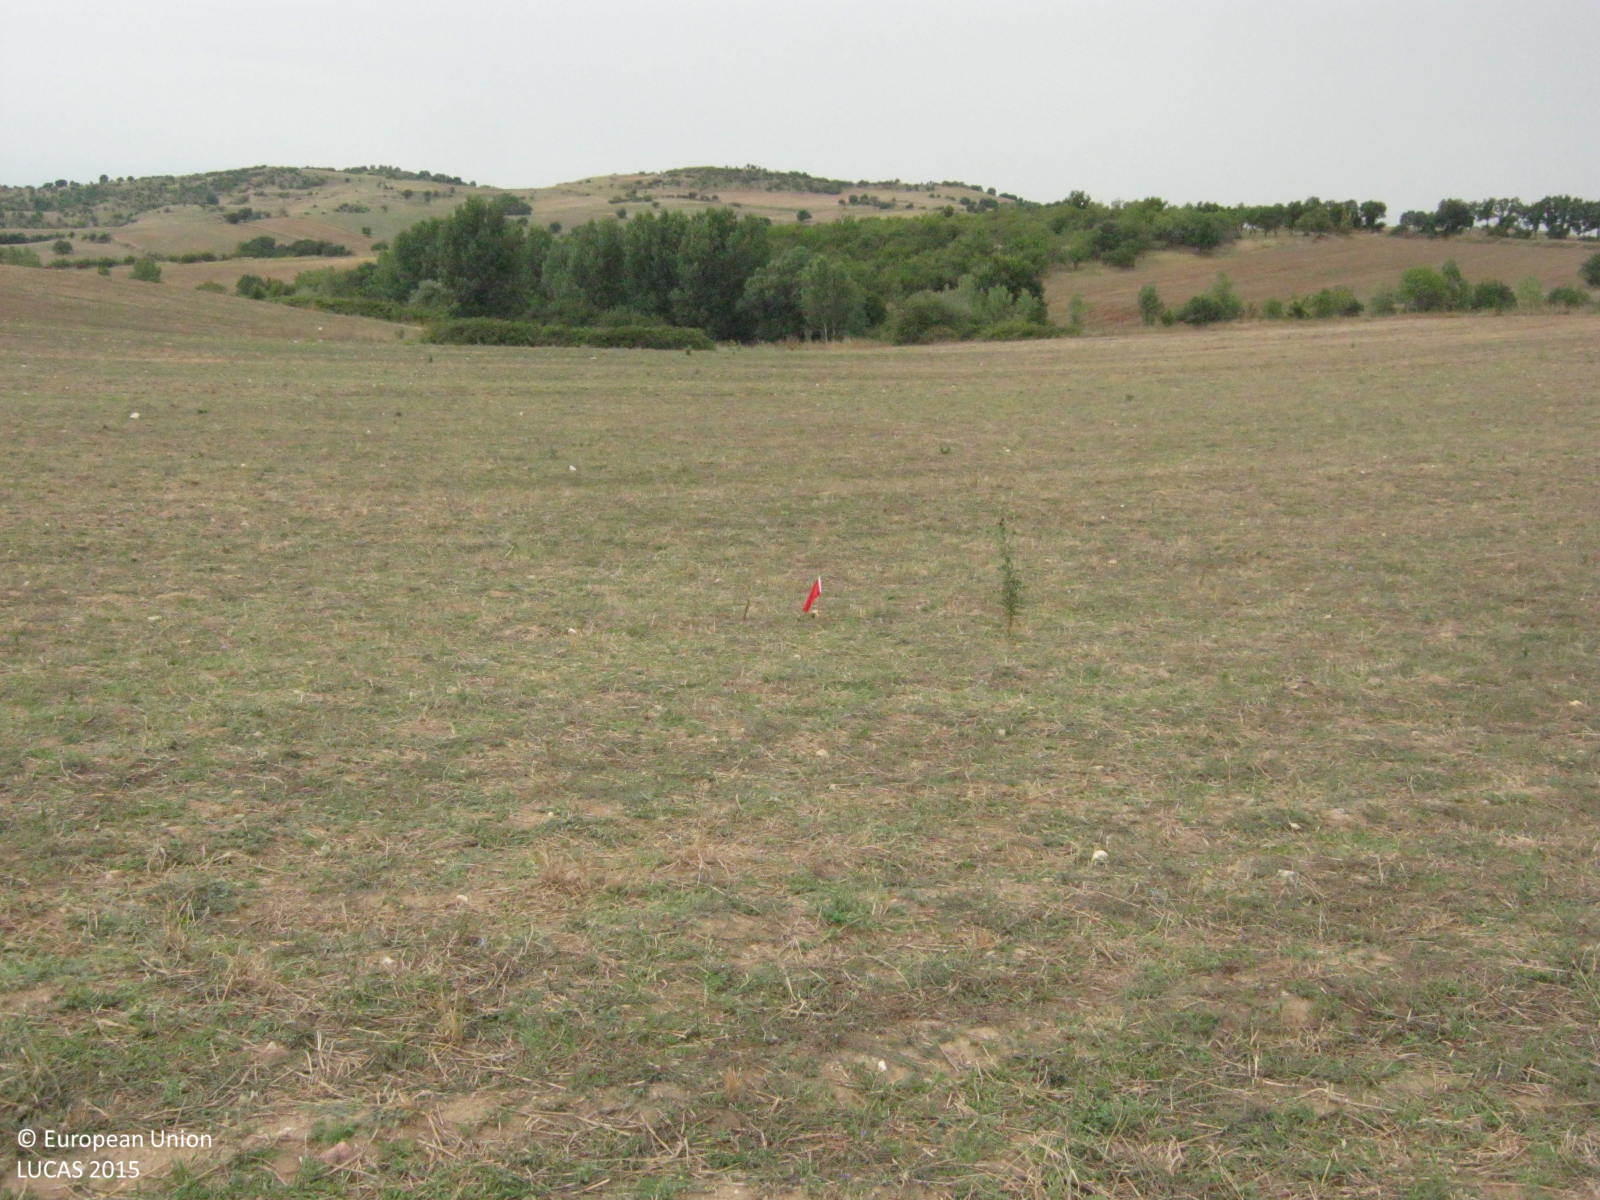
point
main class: Grassland
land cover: Spontaneously vegetated surfaces
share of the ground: > 75 %
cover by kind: herbaceous plants 90 %, consolidated bare surface 10 %
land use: Agriculture (excluding fallow land and kitchen gardens)
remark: Harvested field
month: August
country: GR
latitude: 40.9004
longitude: 22.9853
